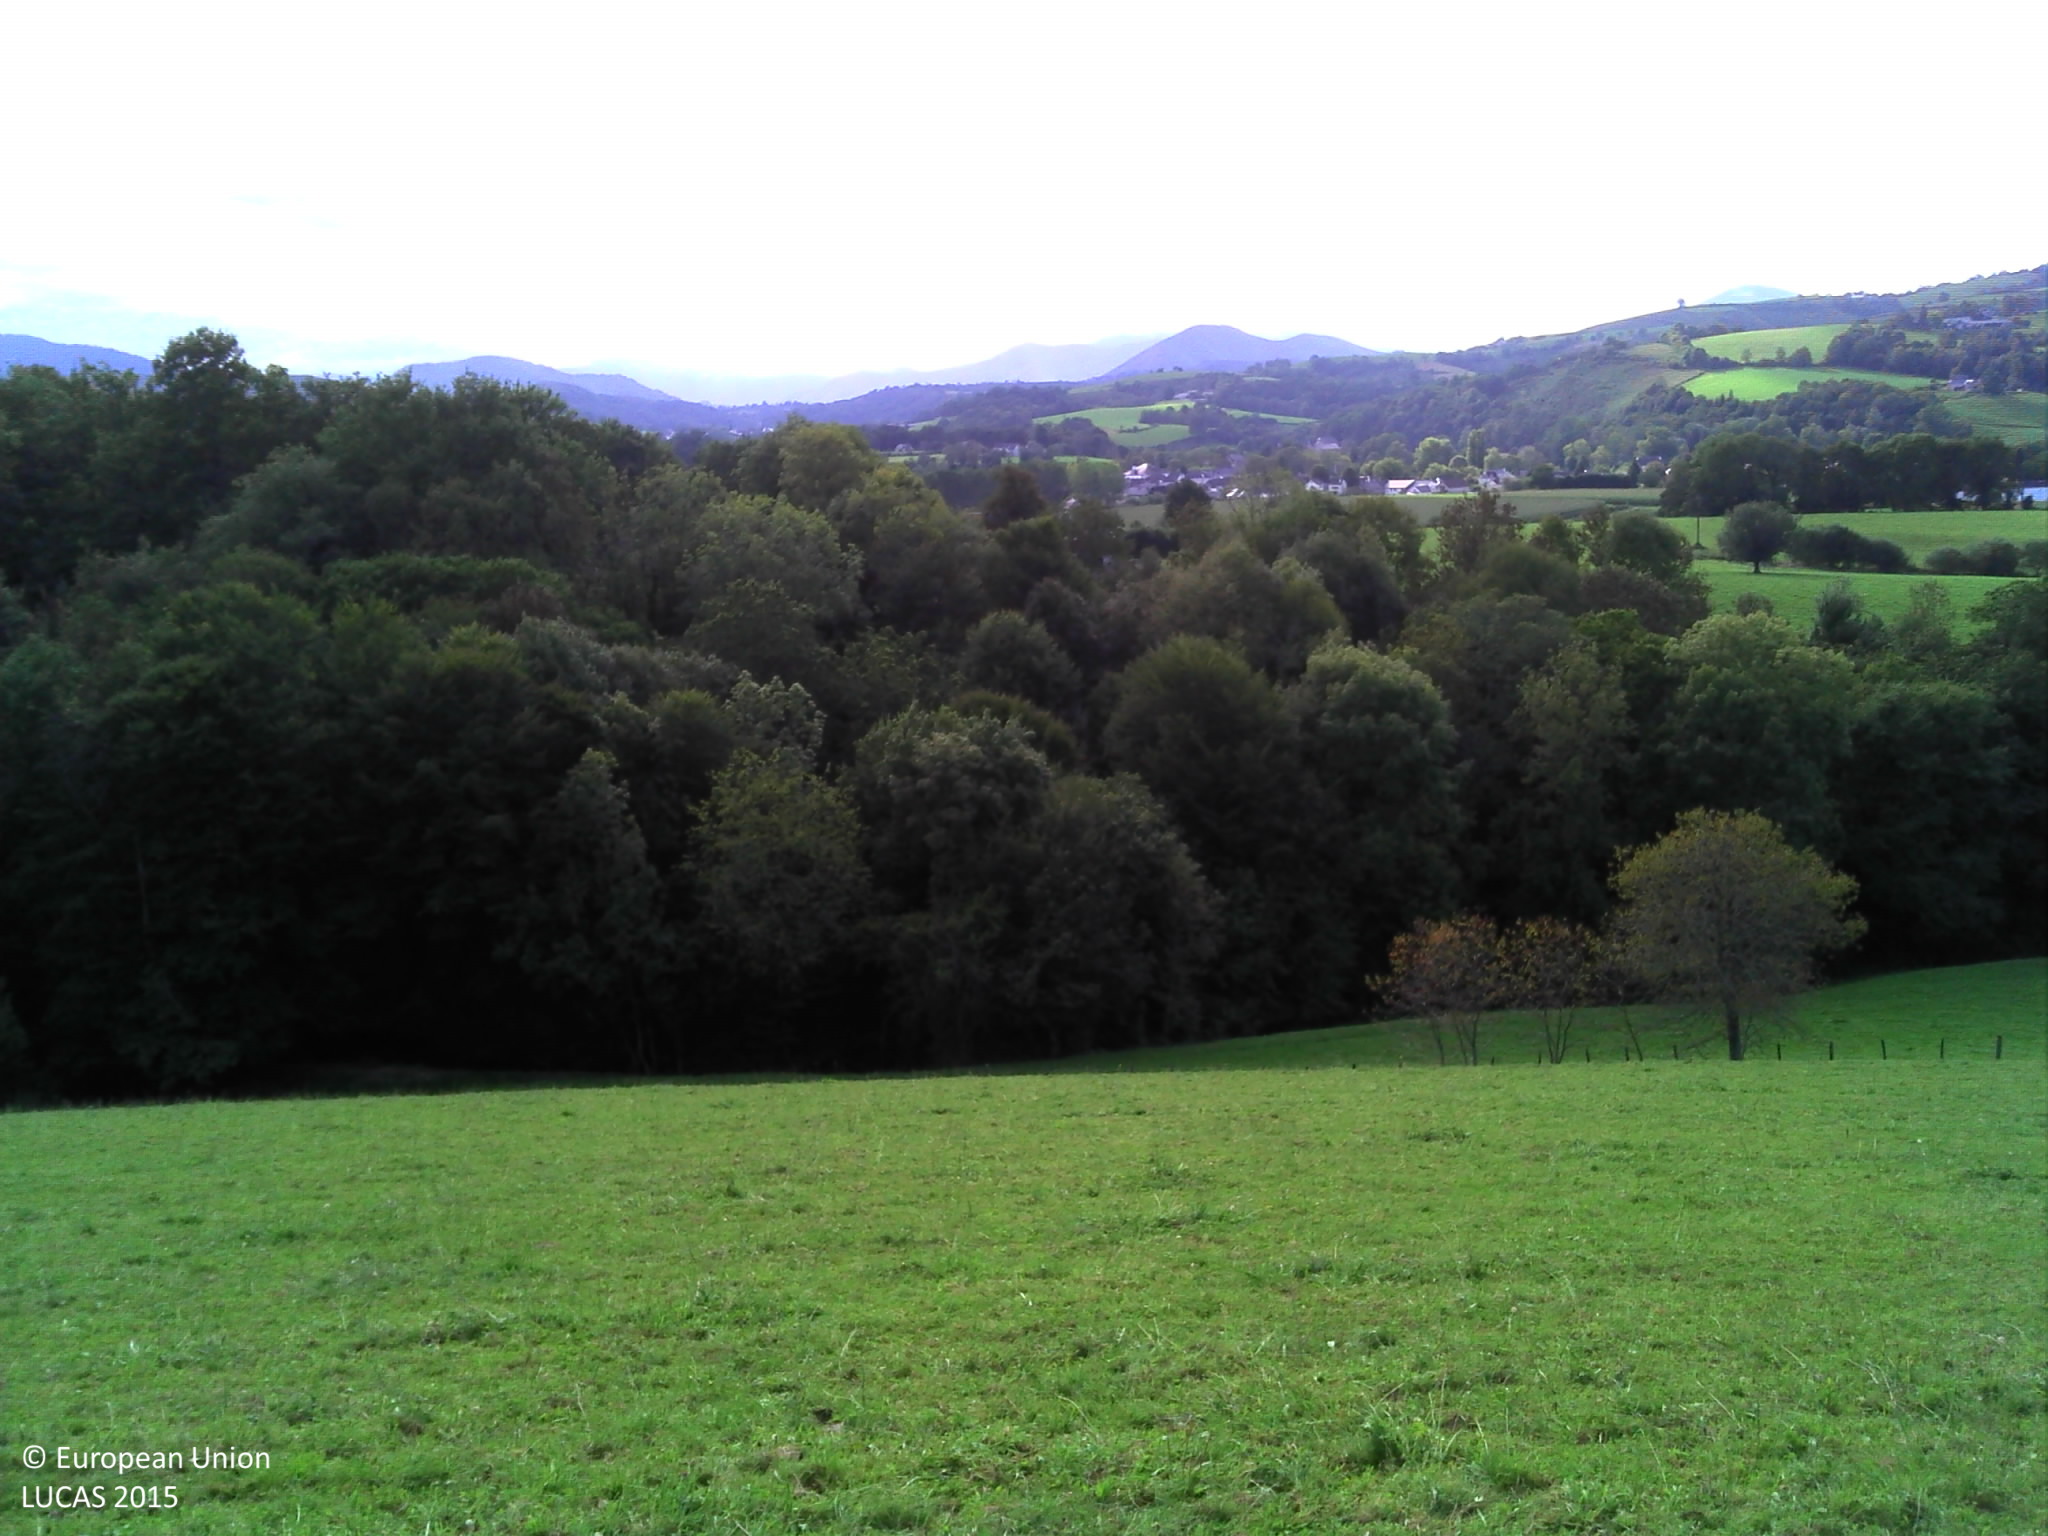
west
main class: Grassland
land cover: Grassland without tree/shrub cover
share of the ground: > 75 %
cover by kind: herbaceous plants 100 %
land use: Agriculture (excluding fallow land and kitchen gardens)
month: September
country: FR
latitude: 43.1214
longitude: -0.7137
